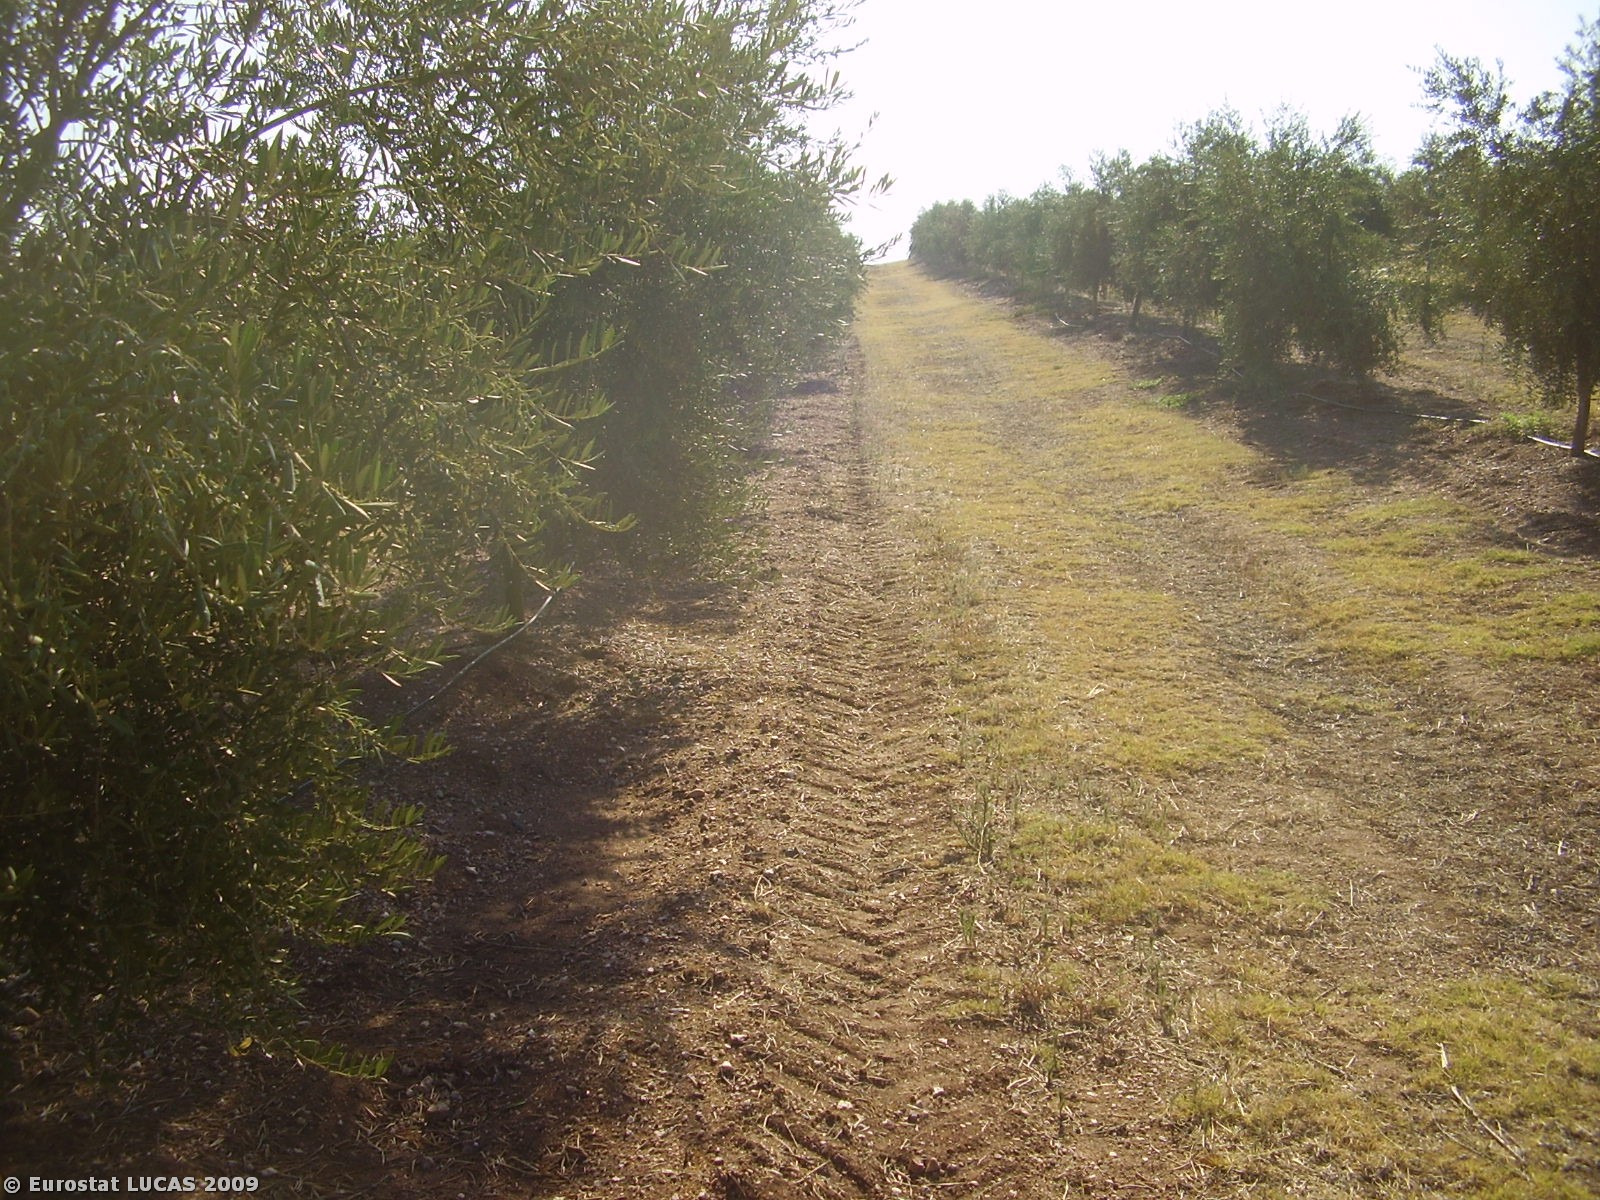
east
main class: Cropland
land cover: Olive groves
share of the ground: 10 - 25 %
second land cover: Spontaneously vegetated surfaces
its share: 50 - 75 %
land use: Agriculture (excluding fallow land and kitchen gardens)
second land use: Fallow land
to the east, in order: Olive groves; Spontaneously vegetated surfaces; Olive groves; Tracks; Fences; Olive groves; Grassland without tree/shrub cover; Olive groves
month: August
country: PT
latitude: 38.0864
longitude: -7.6157
